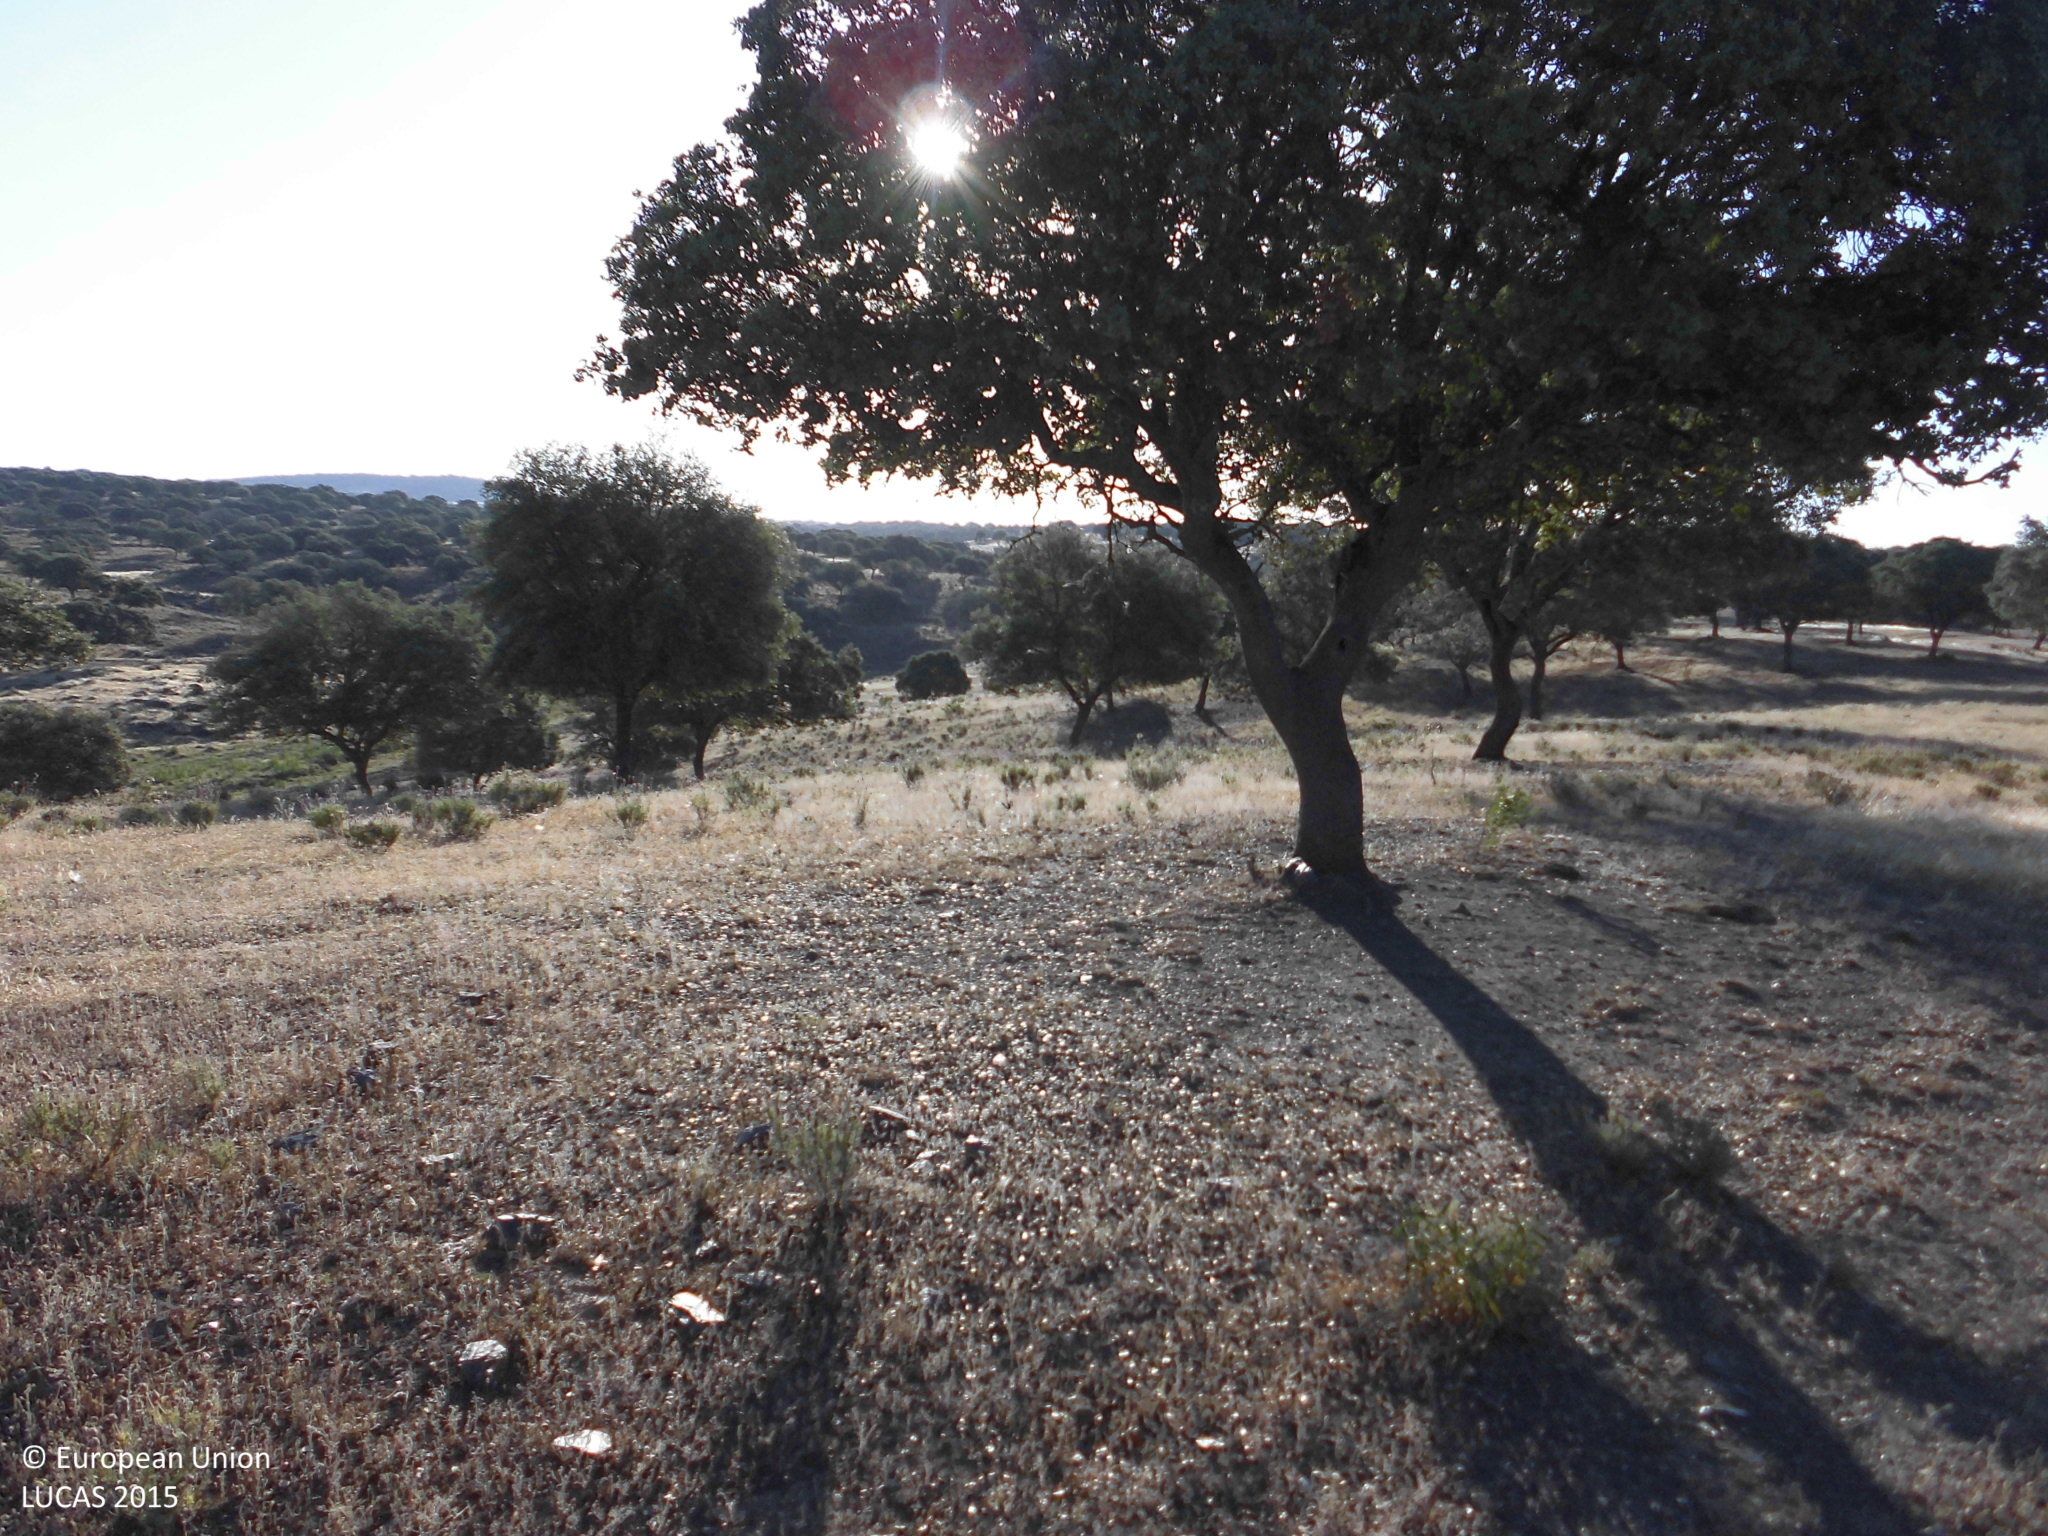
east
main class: Woodland
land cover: Broadleaved woodland
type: broadleaved evergreen forest
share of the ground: 10 - 25 %
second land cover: Grassland without tree/shrub cover
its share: > 75 %
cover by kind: herbaceous plants 80 %, broadleaved forest trees 15 %, consolidated bare surface 5 %
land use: Forestry
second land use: Agriculture (excluding fallow land and kitchen gardens)
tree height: > 5 m
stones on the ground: 10 - 25 %
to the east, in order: Broadleaved woodland; Grassland without tree/shrub cover; Other structural elements; Grassland with sparse tree/shrub cover; Fences; Spontaneously vegetated surfaces
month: May
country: ES
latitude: 39.7749
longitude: -6.9560
